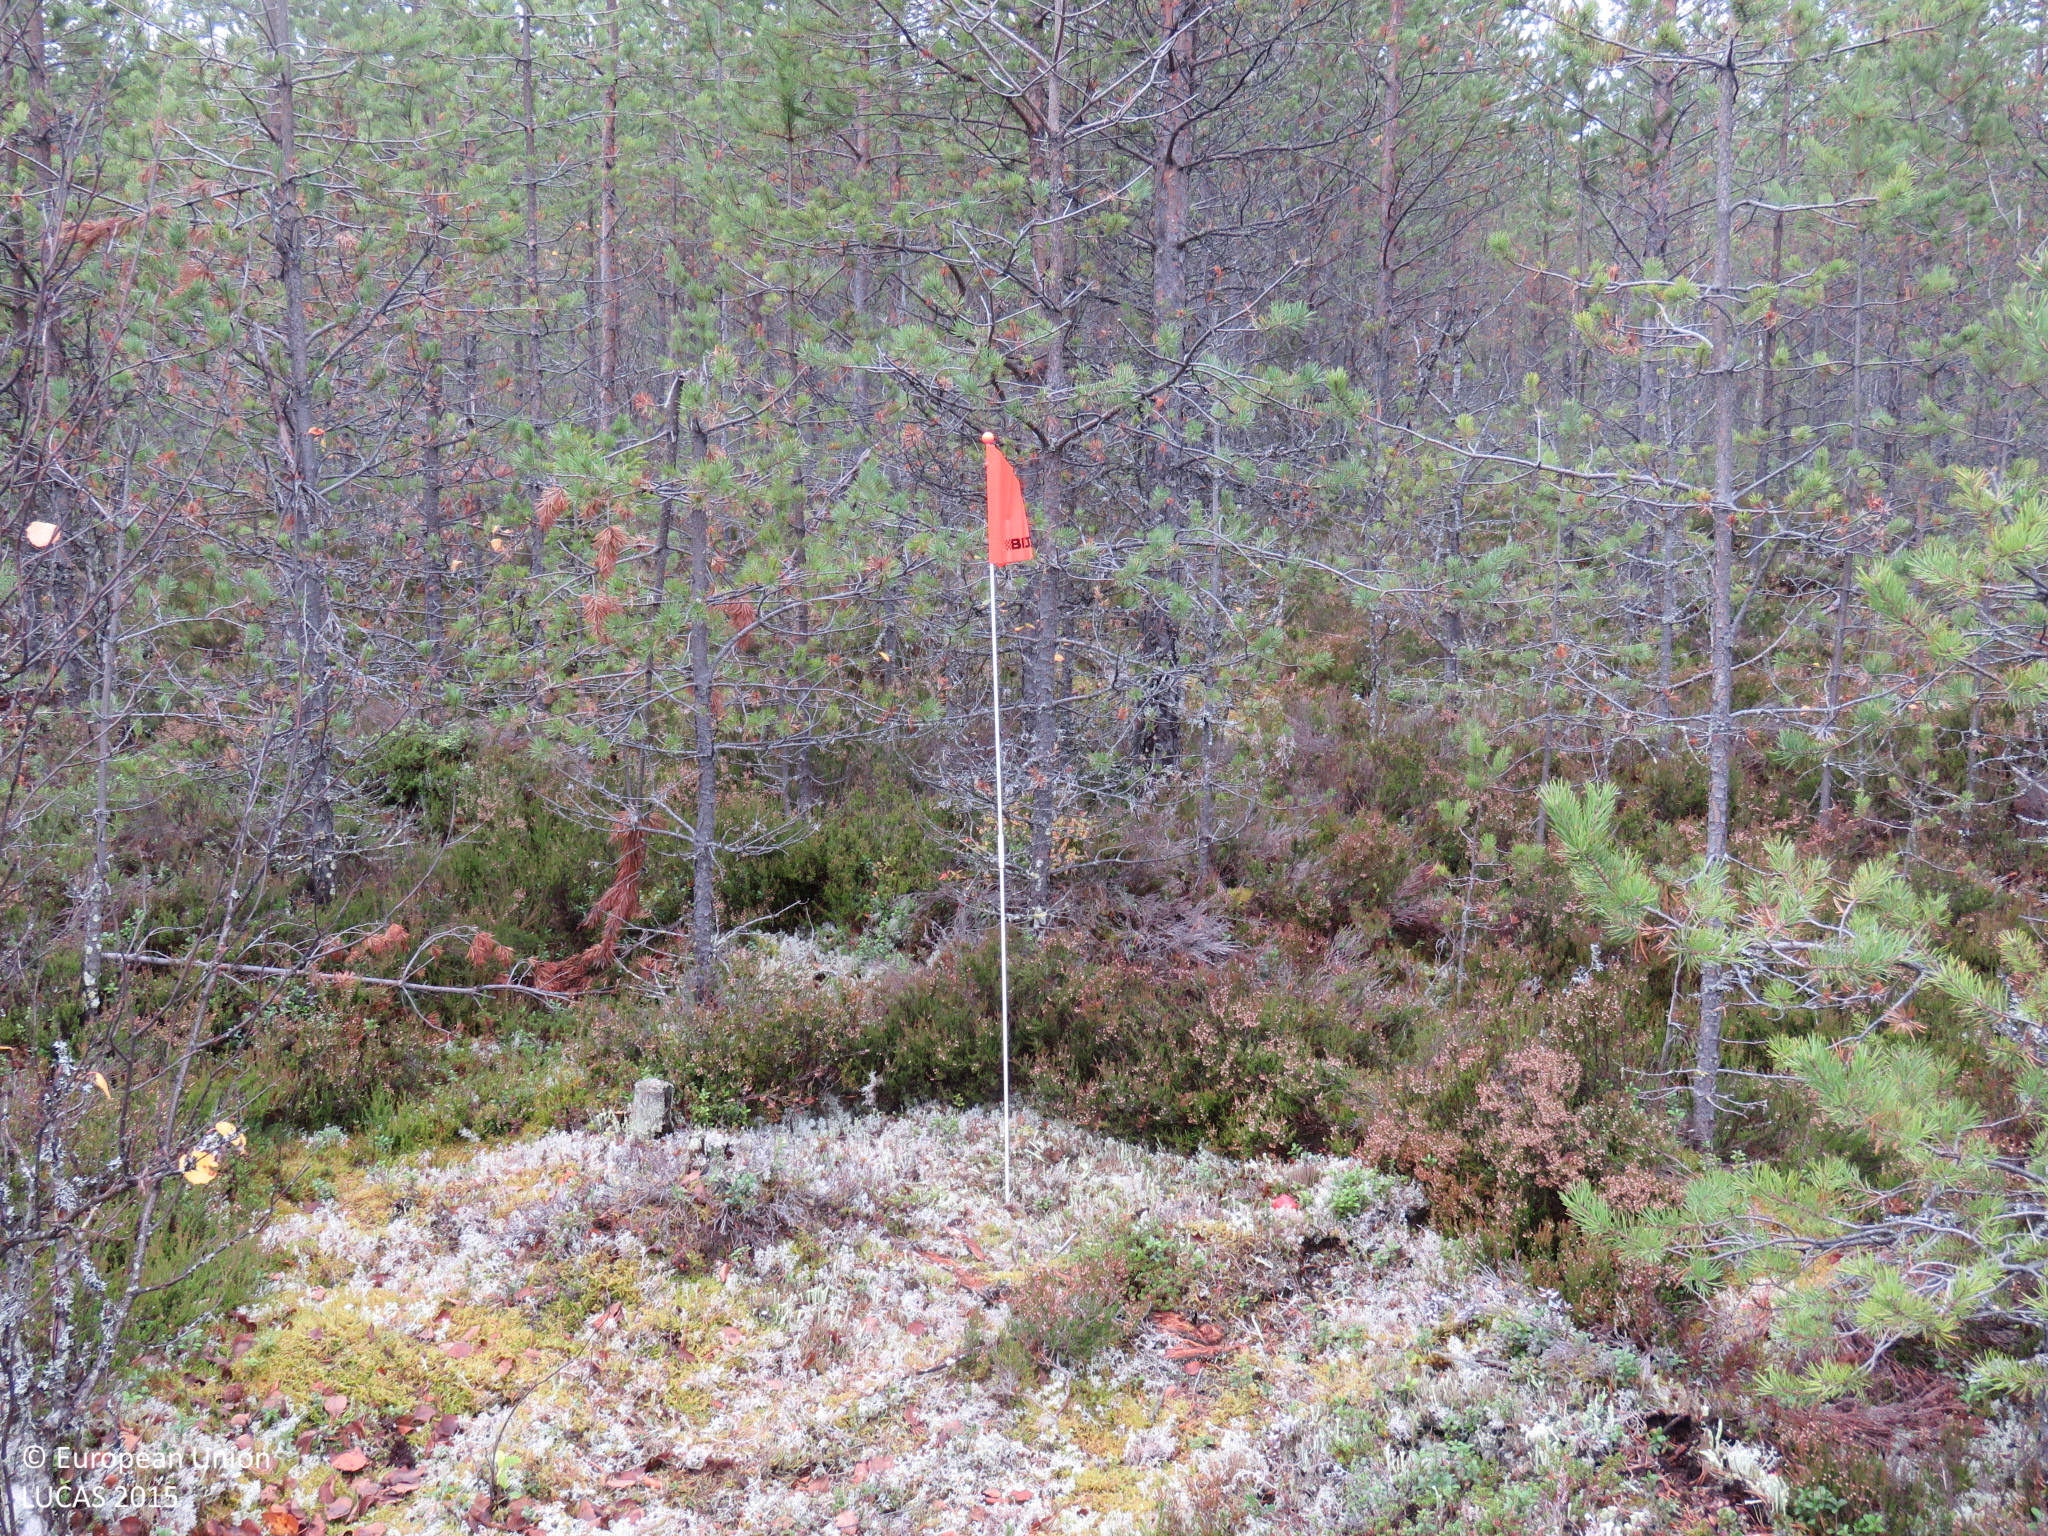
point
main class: Woodland
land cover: Pine dominated coniferous woodland
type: boreal forest
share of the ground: > 75 %
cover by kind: coniferous forest trees 65 %, shrubs 15 %, broadleaved forest trees 10 %, lichens and mosses 10 %
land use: Forestry
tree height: > 5 m
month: September
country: FI
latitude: 64.9393
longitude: 27.3342
